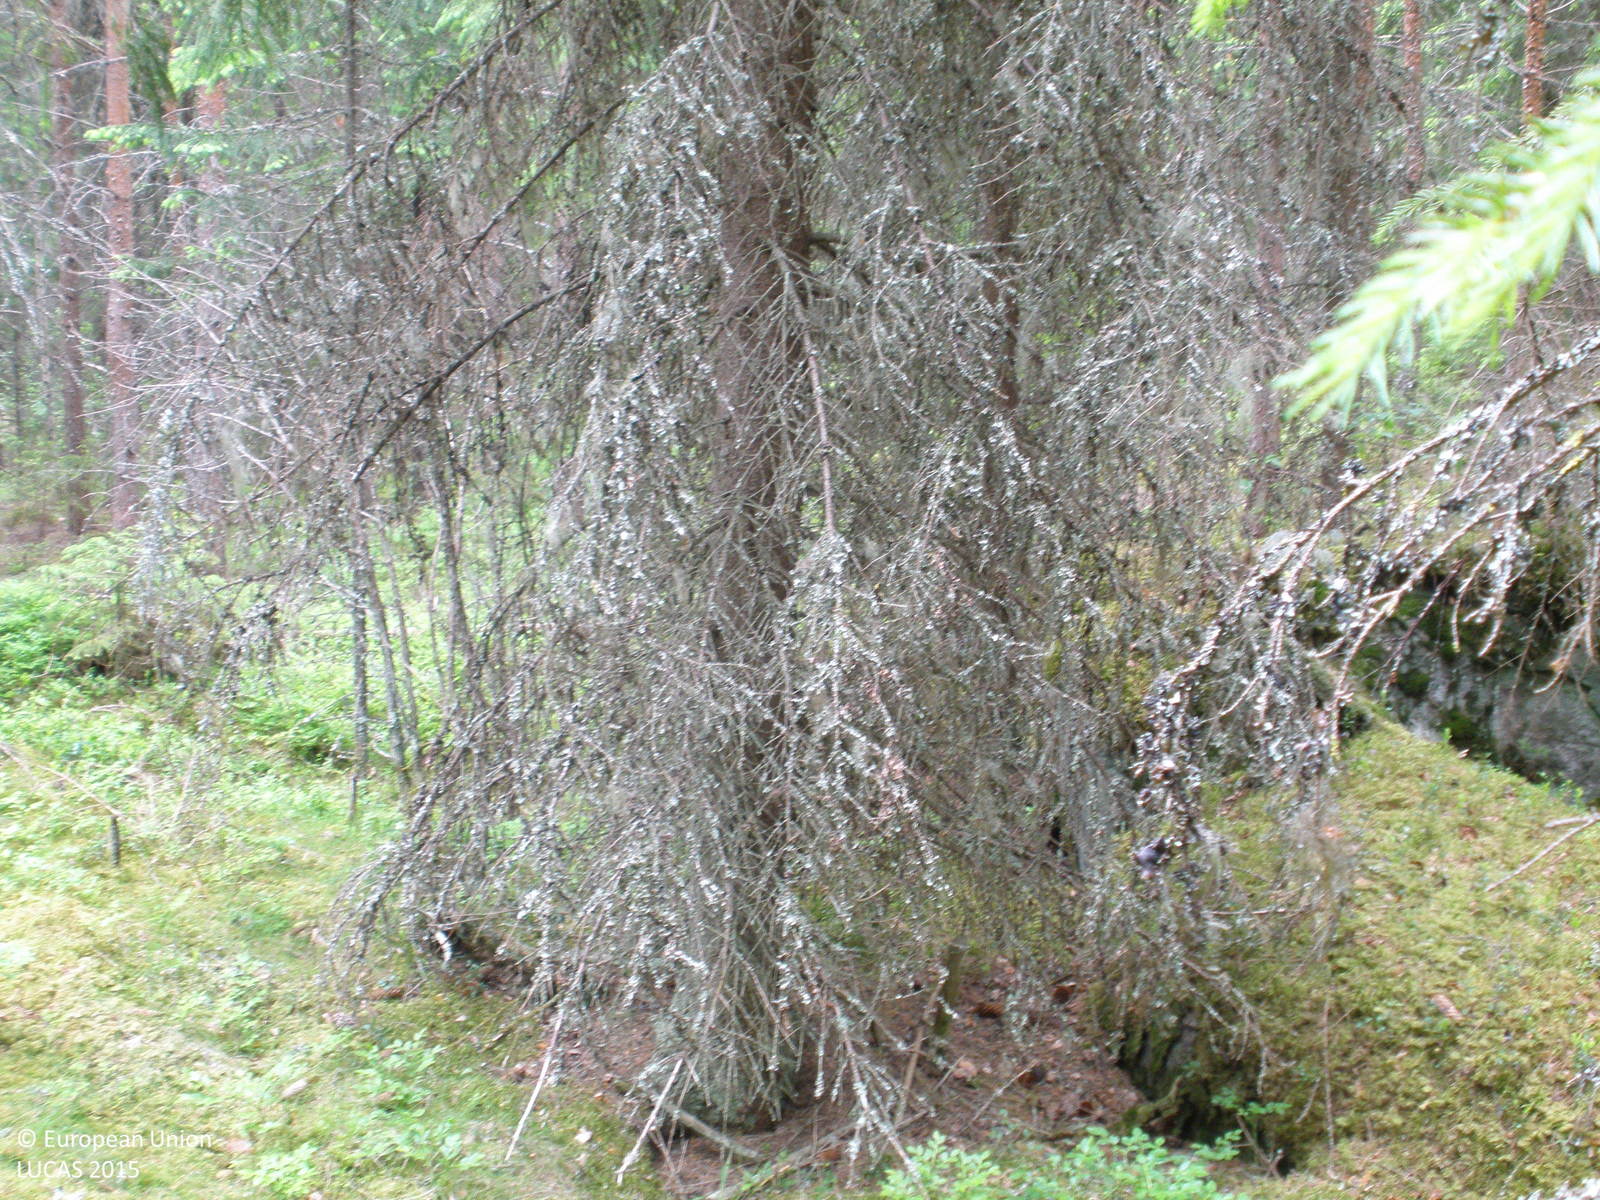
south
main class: Woodland
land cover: Spruce dominated coniferous woodland
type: boreal forest
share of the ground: > 75 %
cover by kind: coniferous forest trees 85 %, lichens and mosses 10 %, broadleaved forest trees 5 %
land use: Forestry
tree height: > 5 m
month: June
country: FI
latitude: 61.3308
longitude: 24.5447
